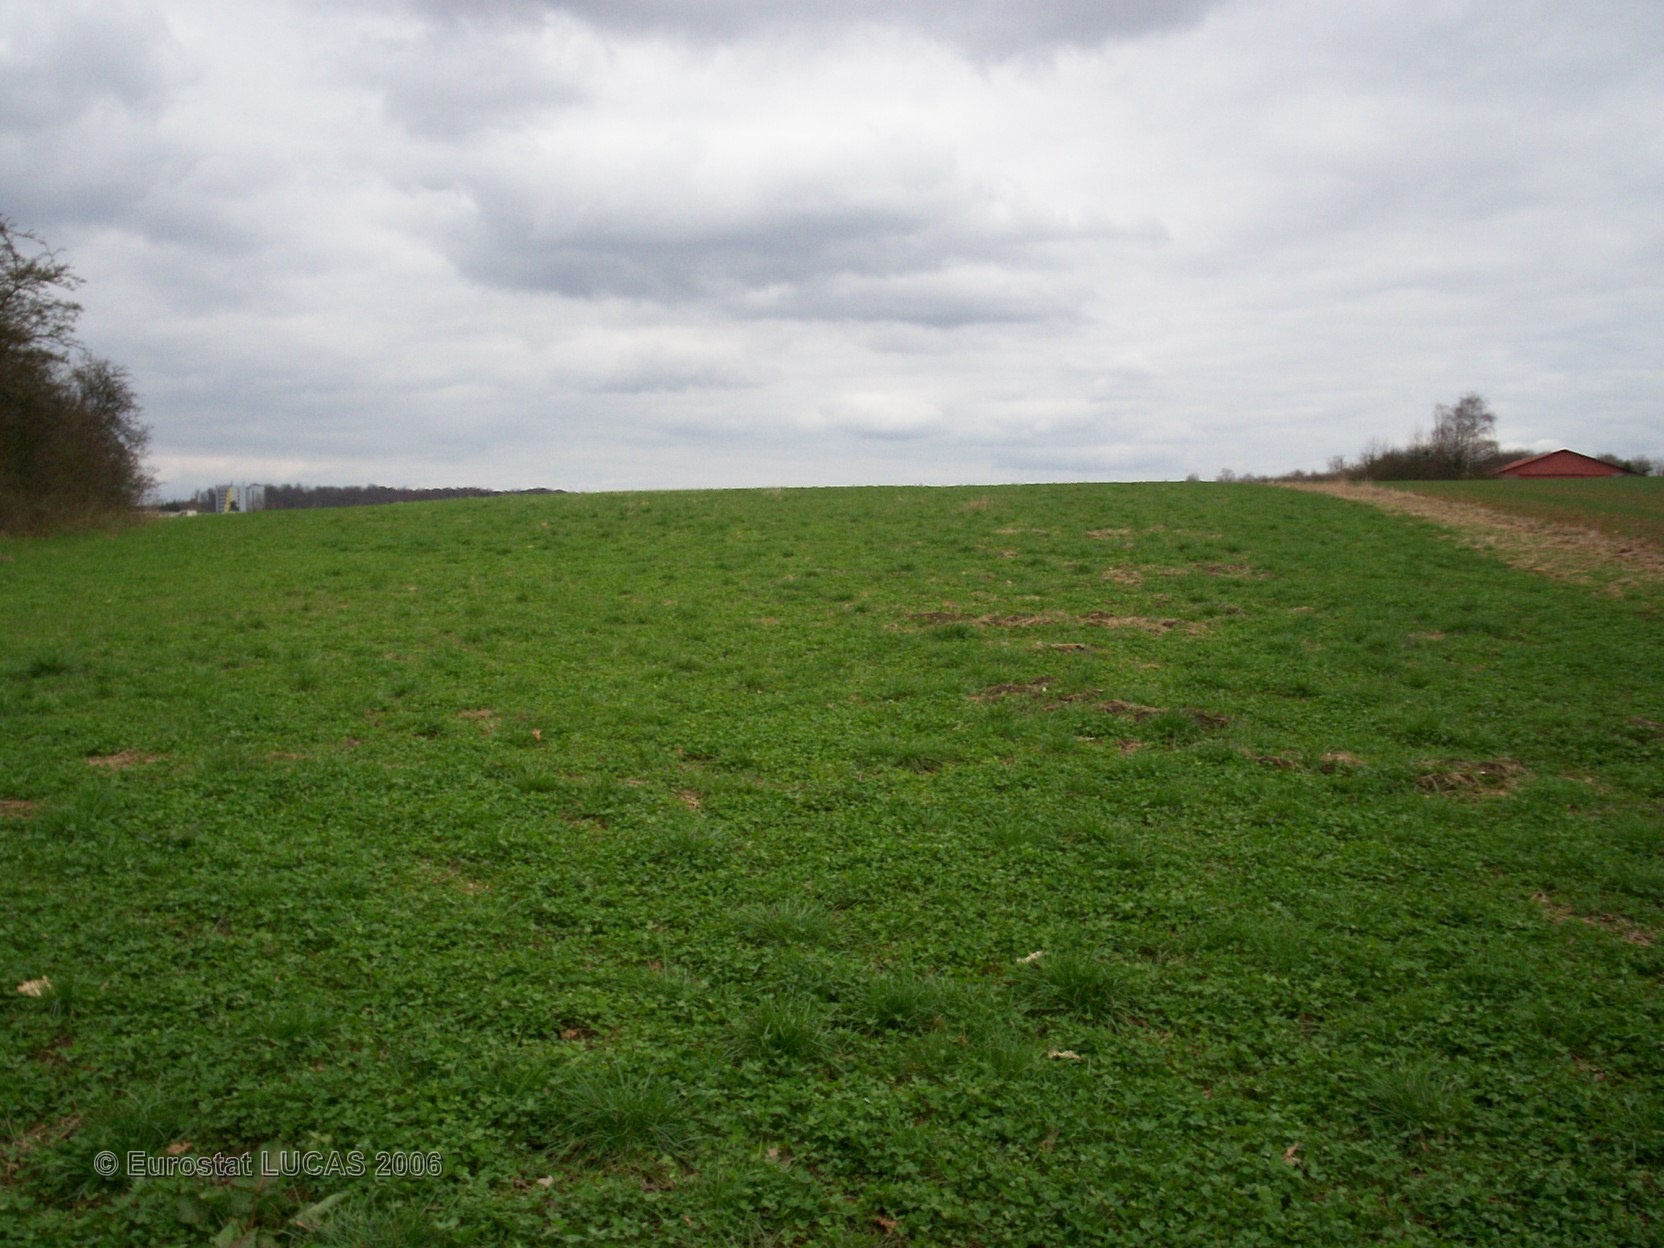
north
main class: Cropland
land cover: Clovers
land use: Agriculture (excluding fallow land and kitchen gardens)
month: April
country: FR
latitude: 47.5287
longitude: 6.8006
